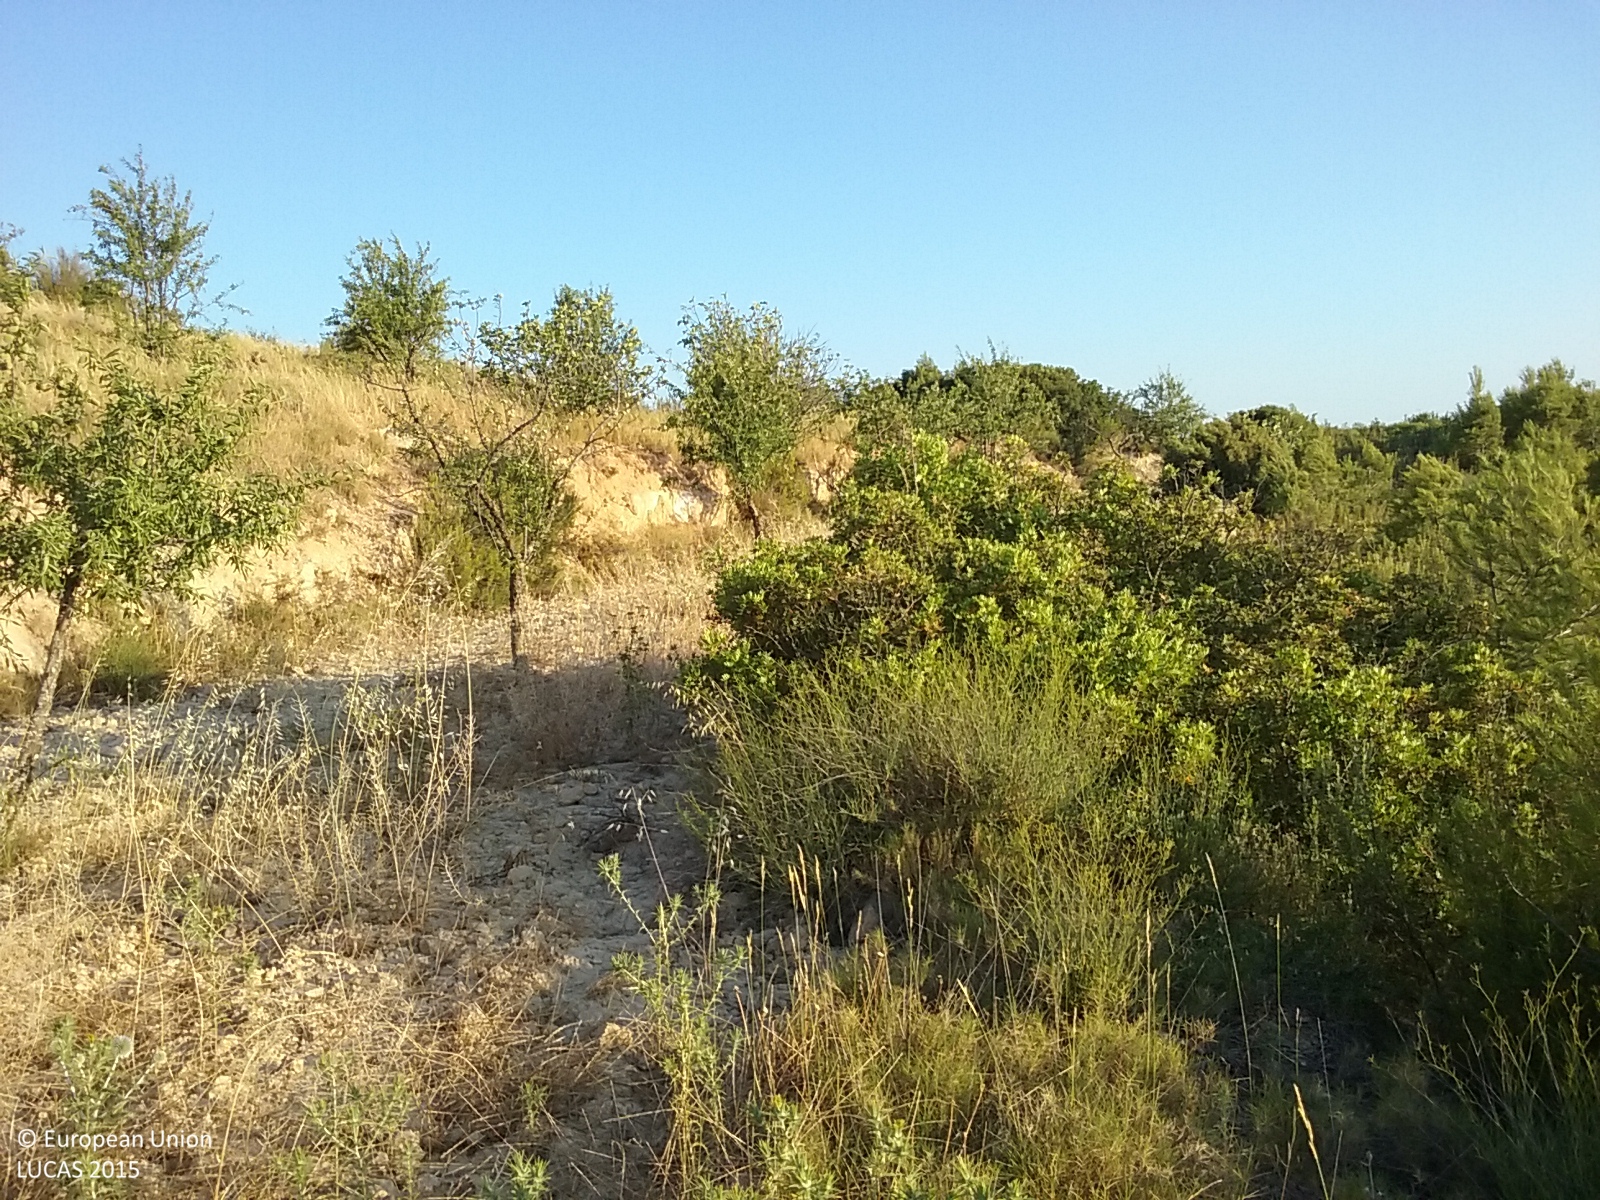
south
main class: Woodland
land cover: Pine dominated coniferous woodland
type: coniferous forest of the mediterranean region
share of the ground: > 75 %
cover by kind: coniferous forest trees 85 %, shrubs 15 %
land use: Semi-natural and natural areas not in use
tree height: < 5 m
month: June
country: ES
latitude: 41.2118
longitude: 0.3649
